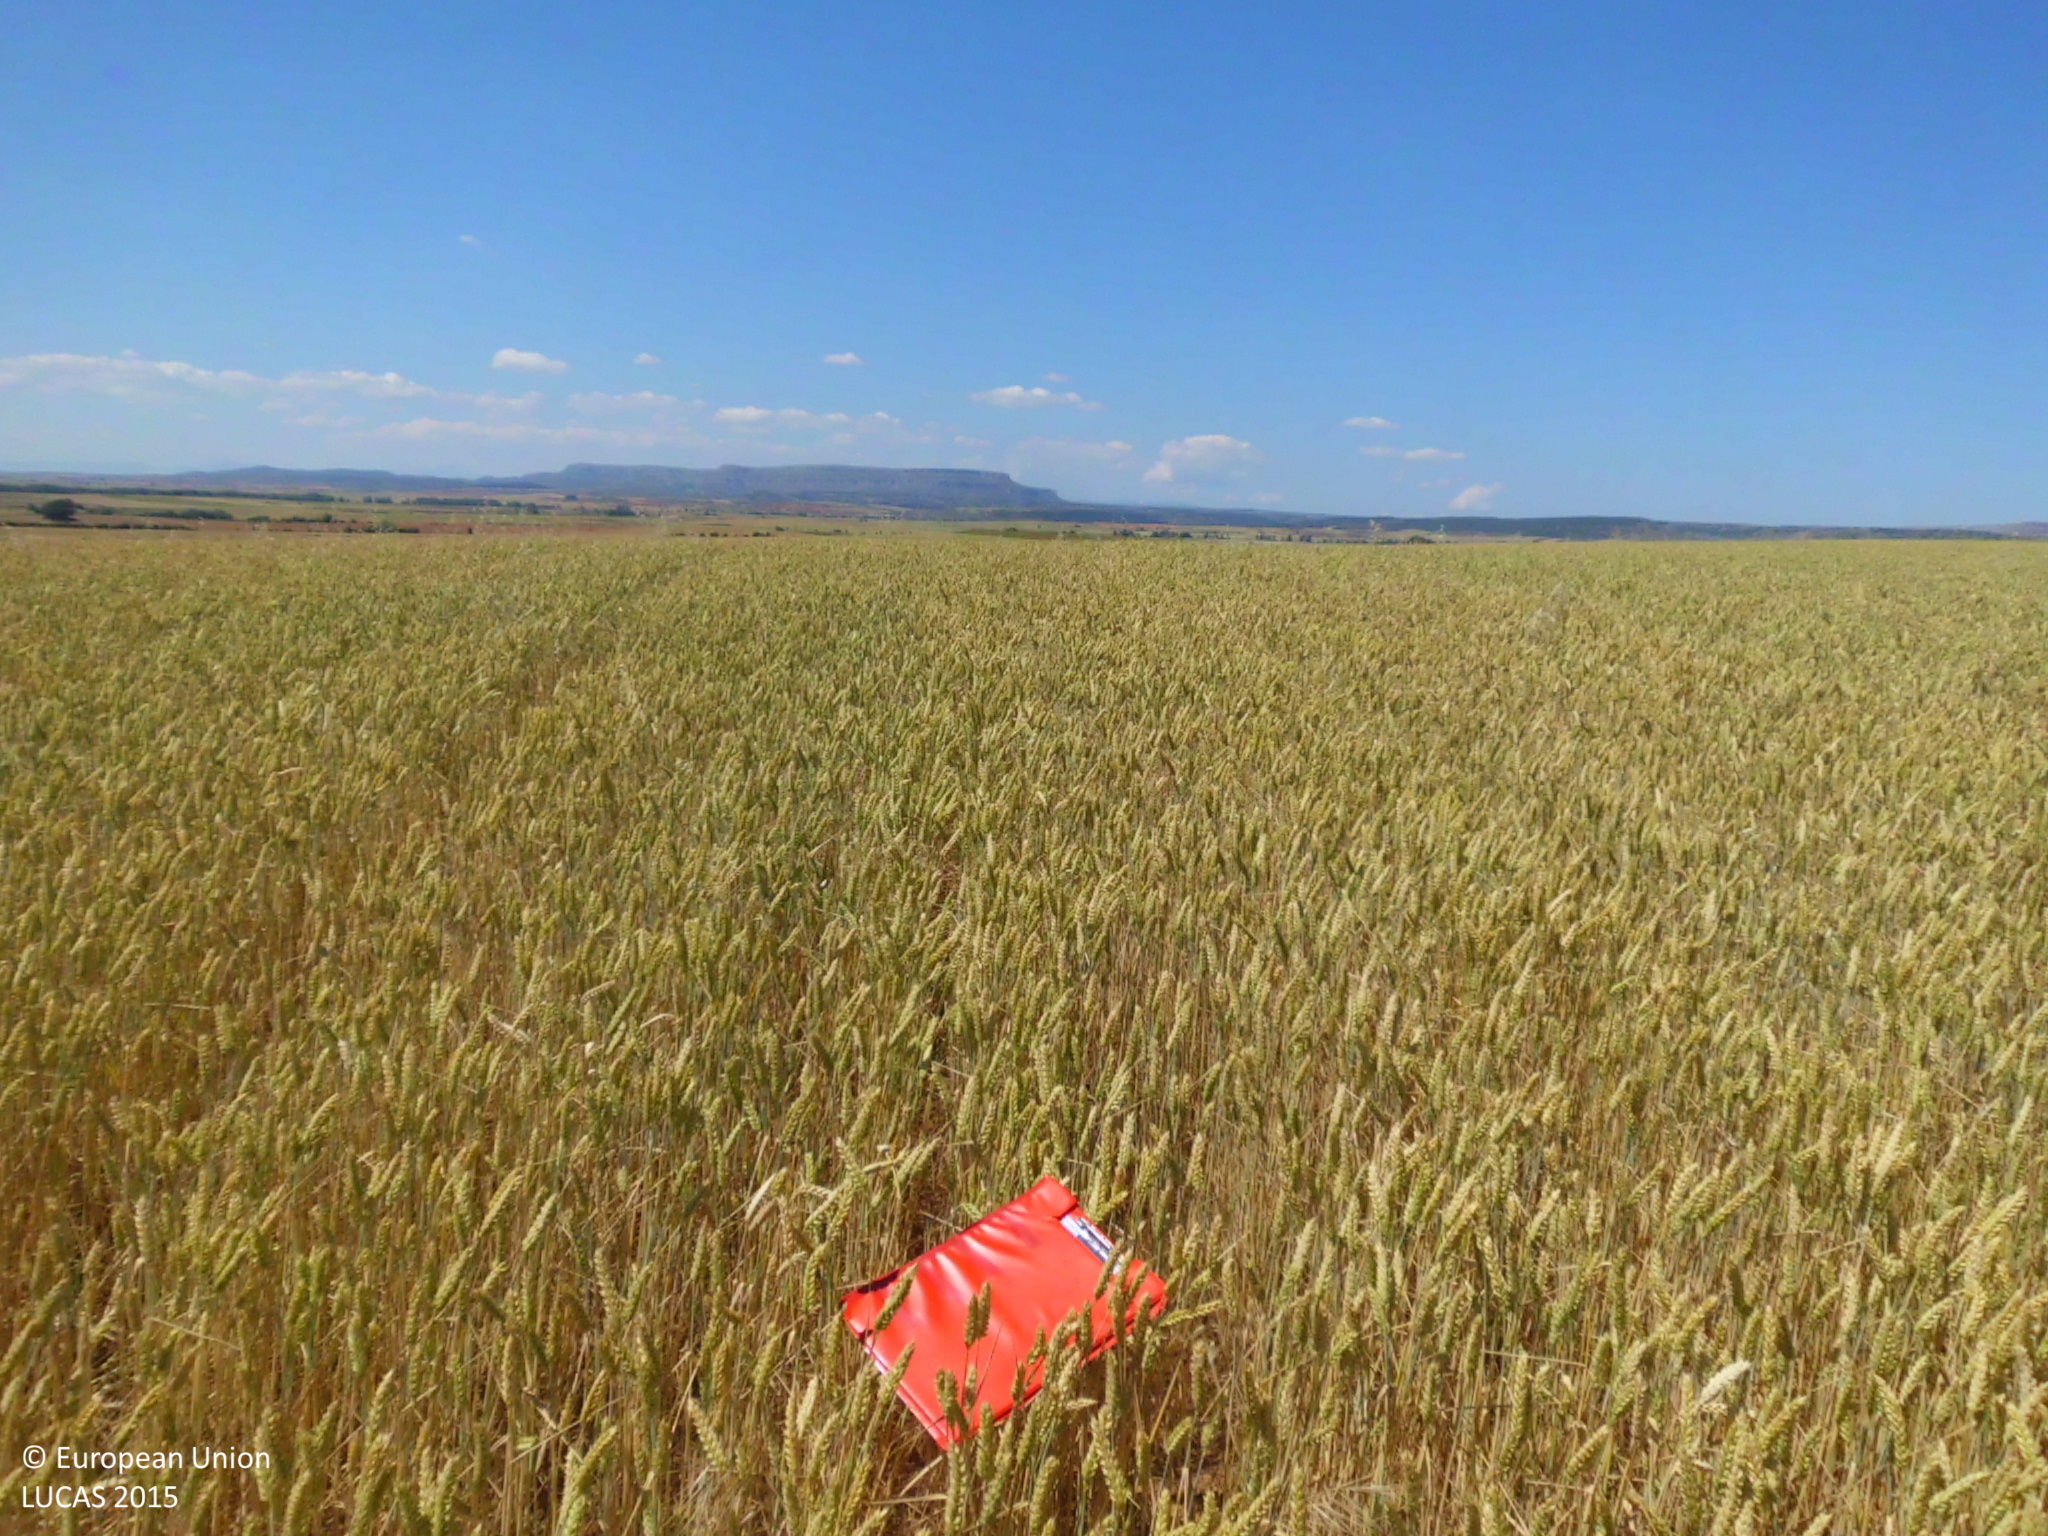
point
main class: Cropland
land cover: Common wheat
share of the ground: > 75 %
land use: Agriculture (excluding fallow land and kitchen gardens)
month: June
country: ES
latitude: 42.5462
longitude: -4.0604
